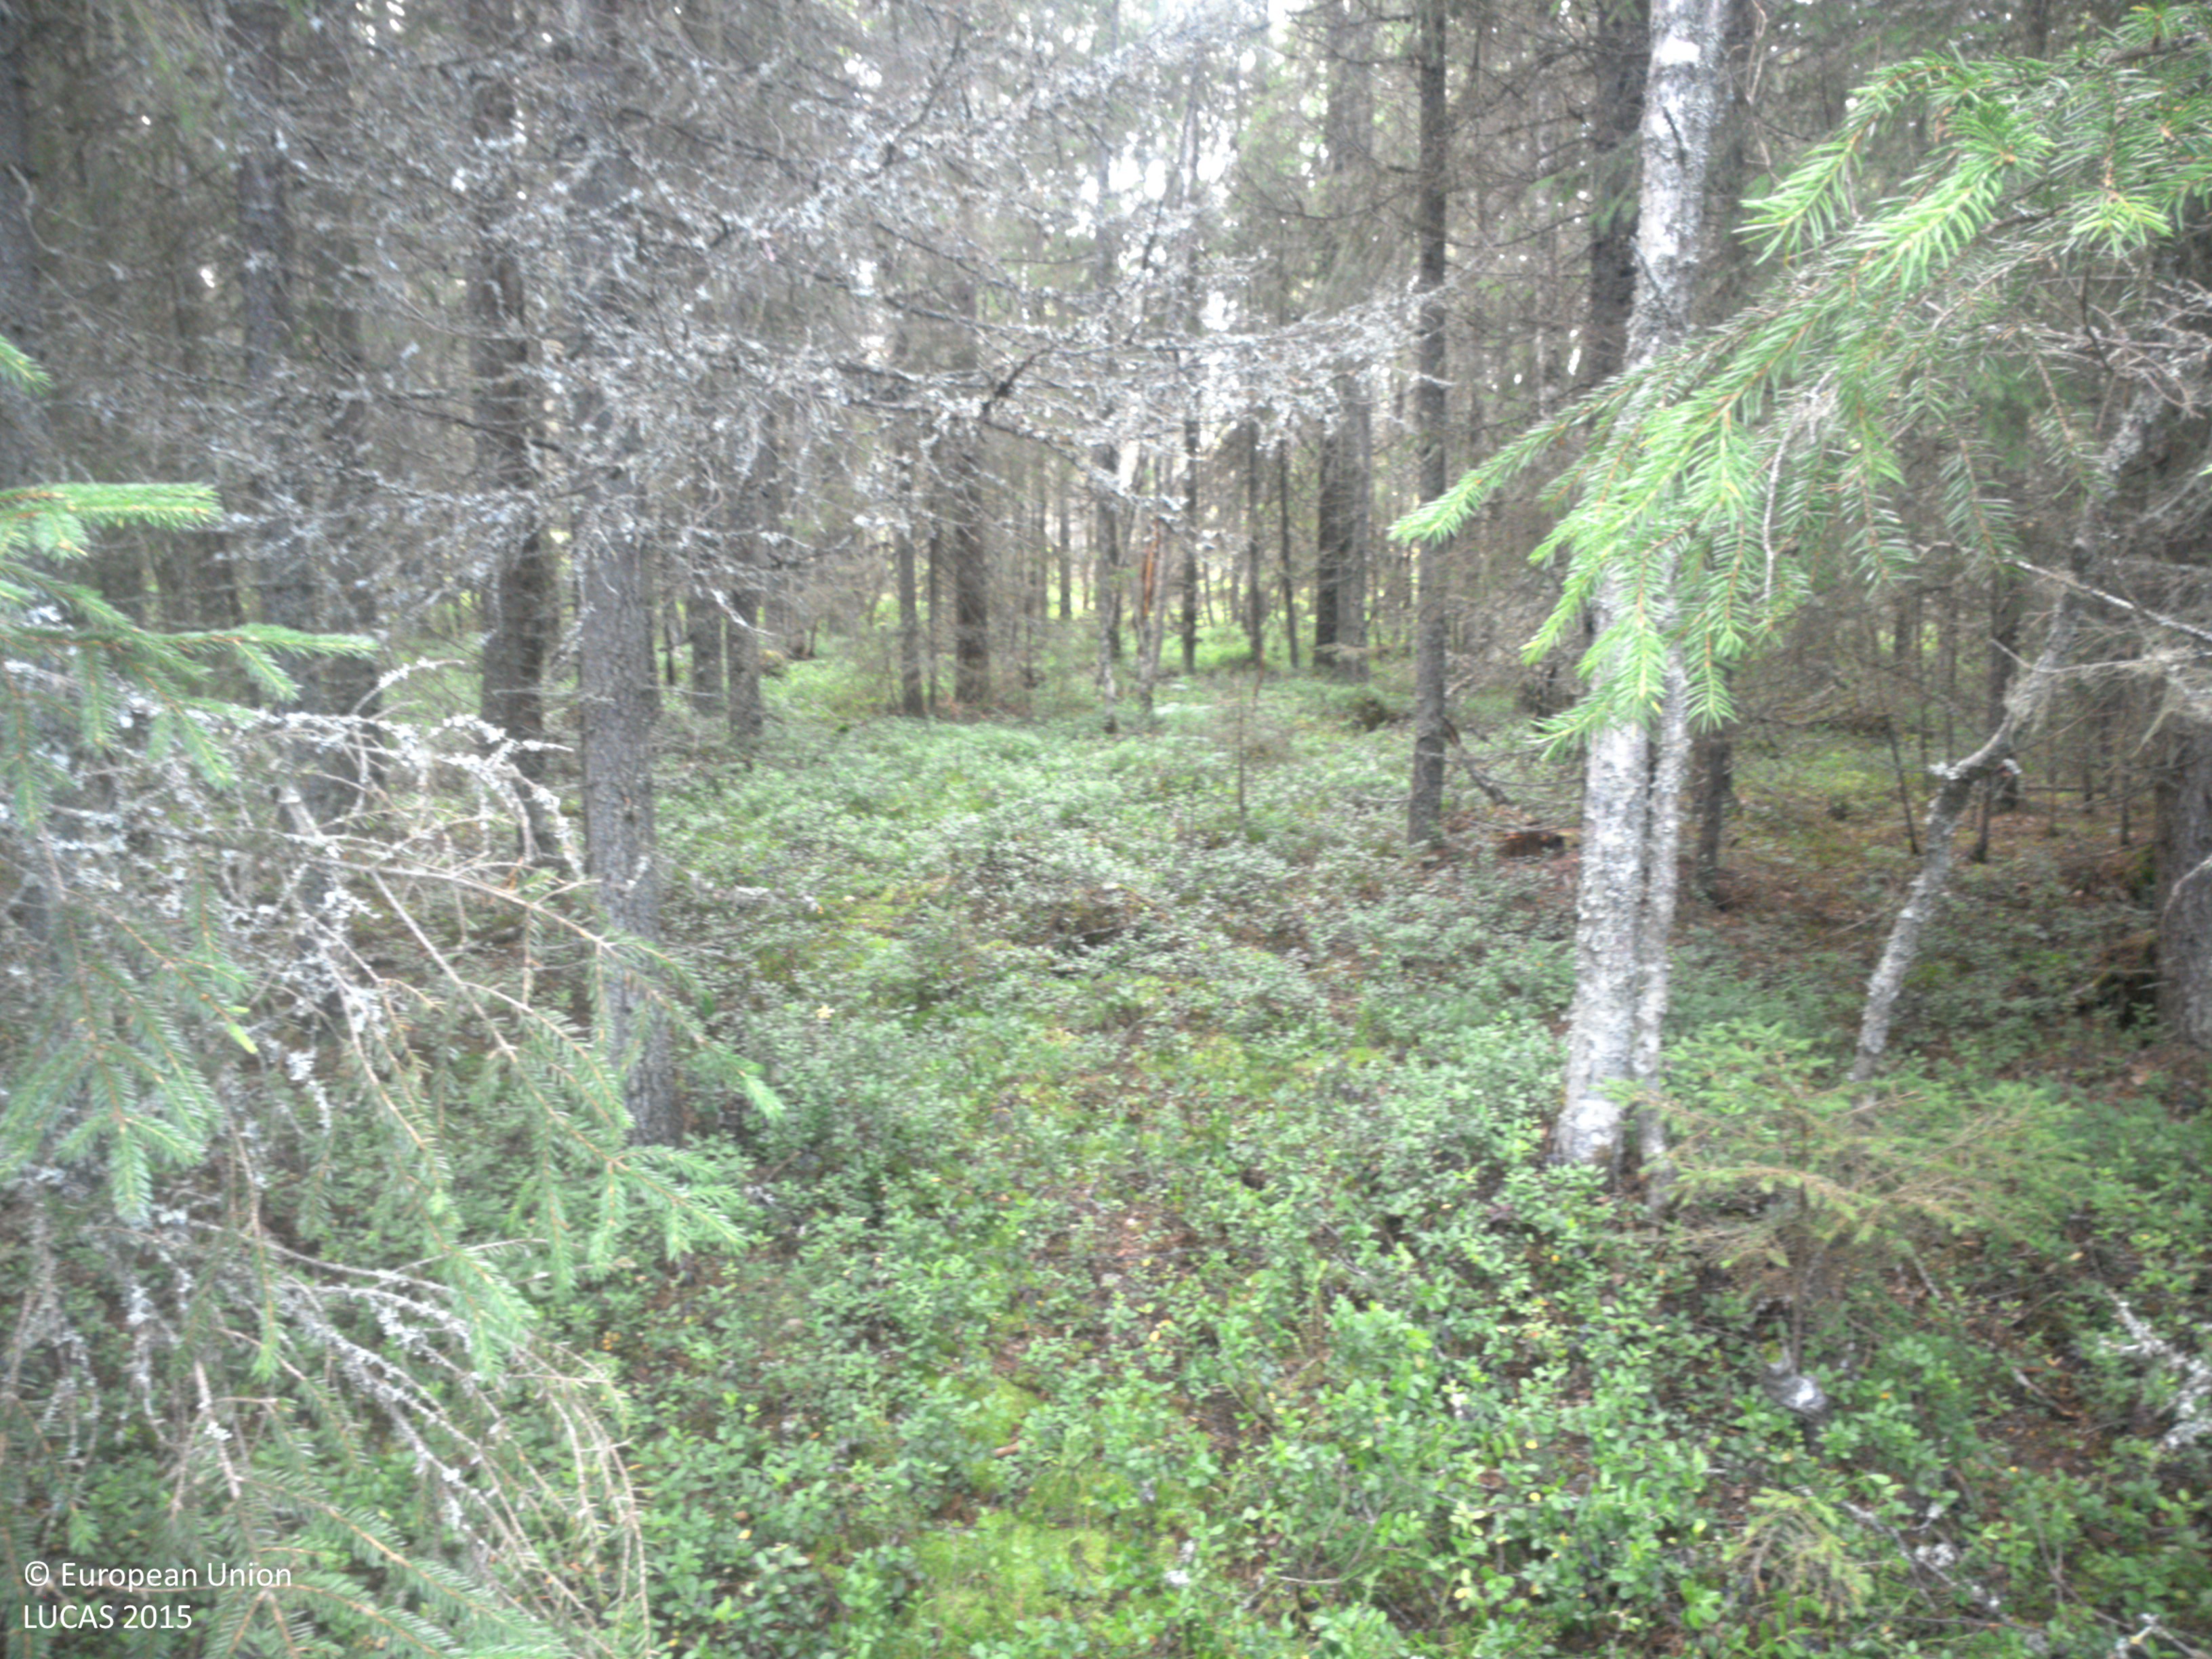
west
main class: Woodland
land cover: Other mixed woodland
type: boreal forest
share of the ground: 50 - 75 %
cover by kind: coniferous forest trees 40 %, broadleaved forest trees 20 %, shrubs 20 %, herbaceous plants 20 %
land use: Forestry
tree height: > 5 m
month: July
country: SE
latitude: 63.4822
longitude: 19.3950
